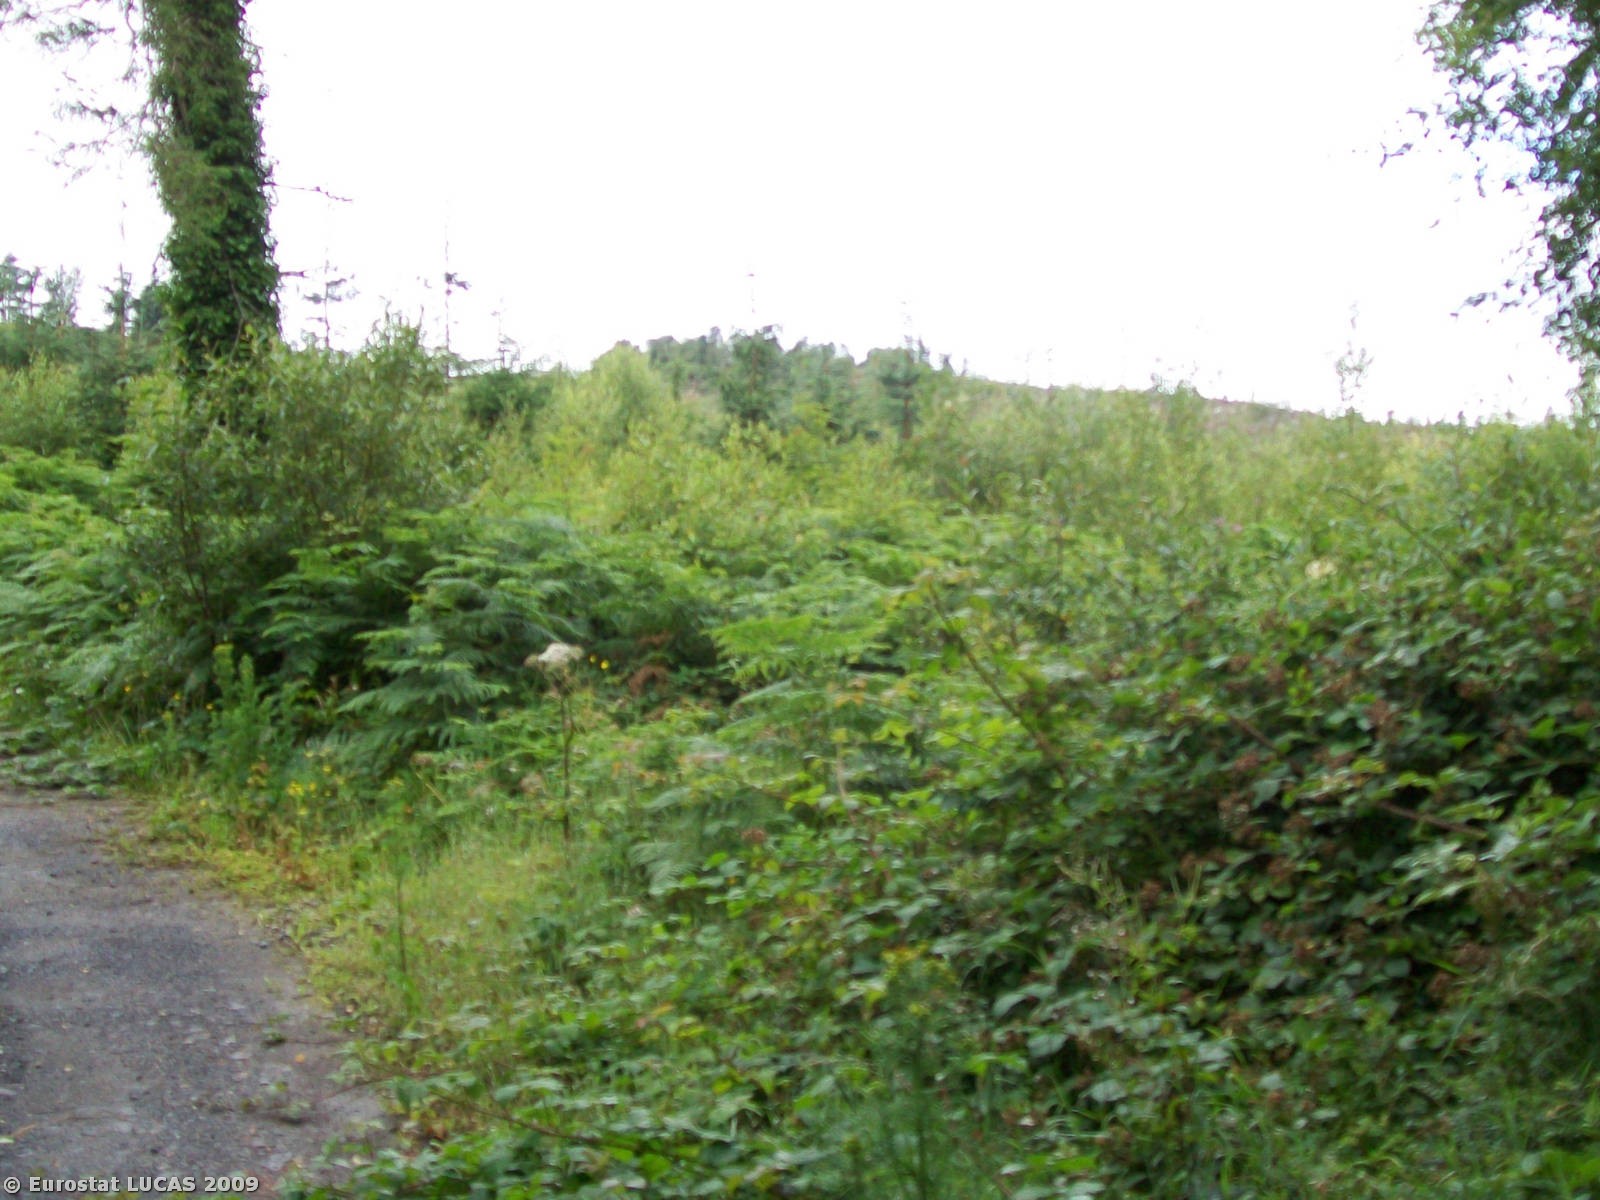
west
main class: Grassland
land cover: Grassland without tree/shrub cover
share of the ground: > 75 %
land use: Agriculture (excluding fallow land and kitchen gardens)
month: July
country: IE
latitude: 53.9705
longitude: -9.1041
